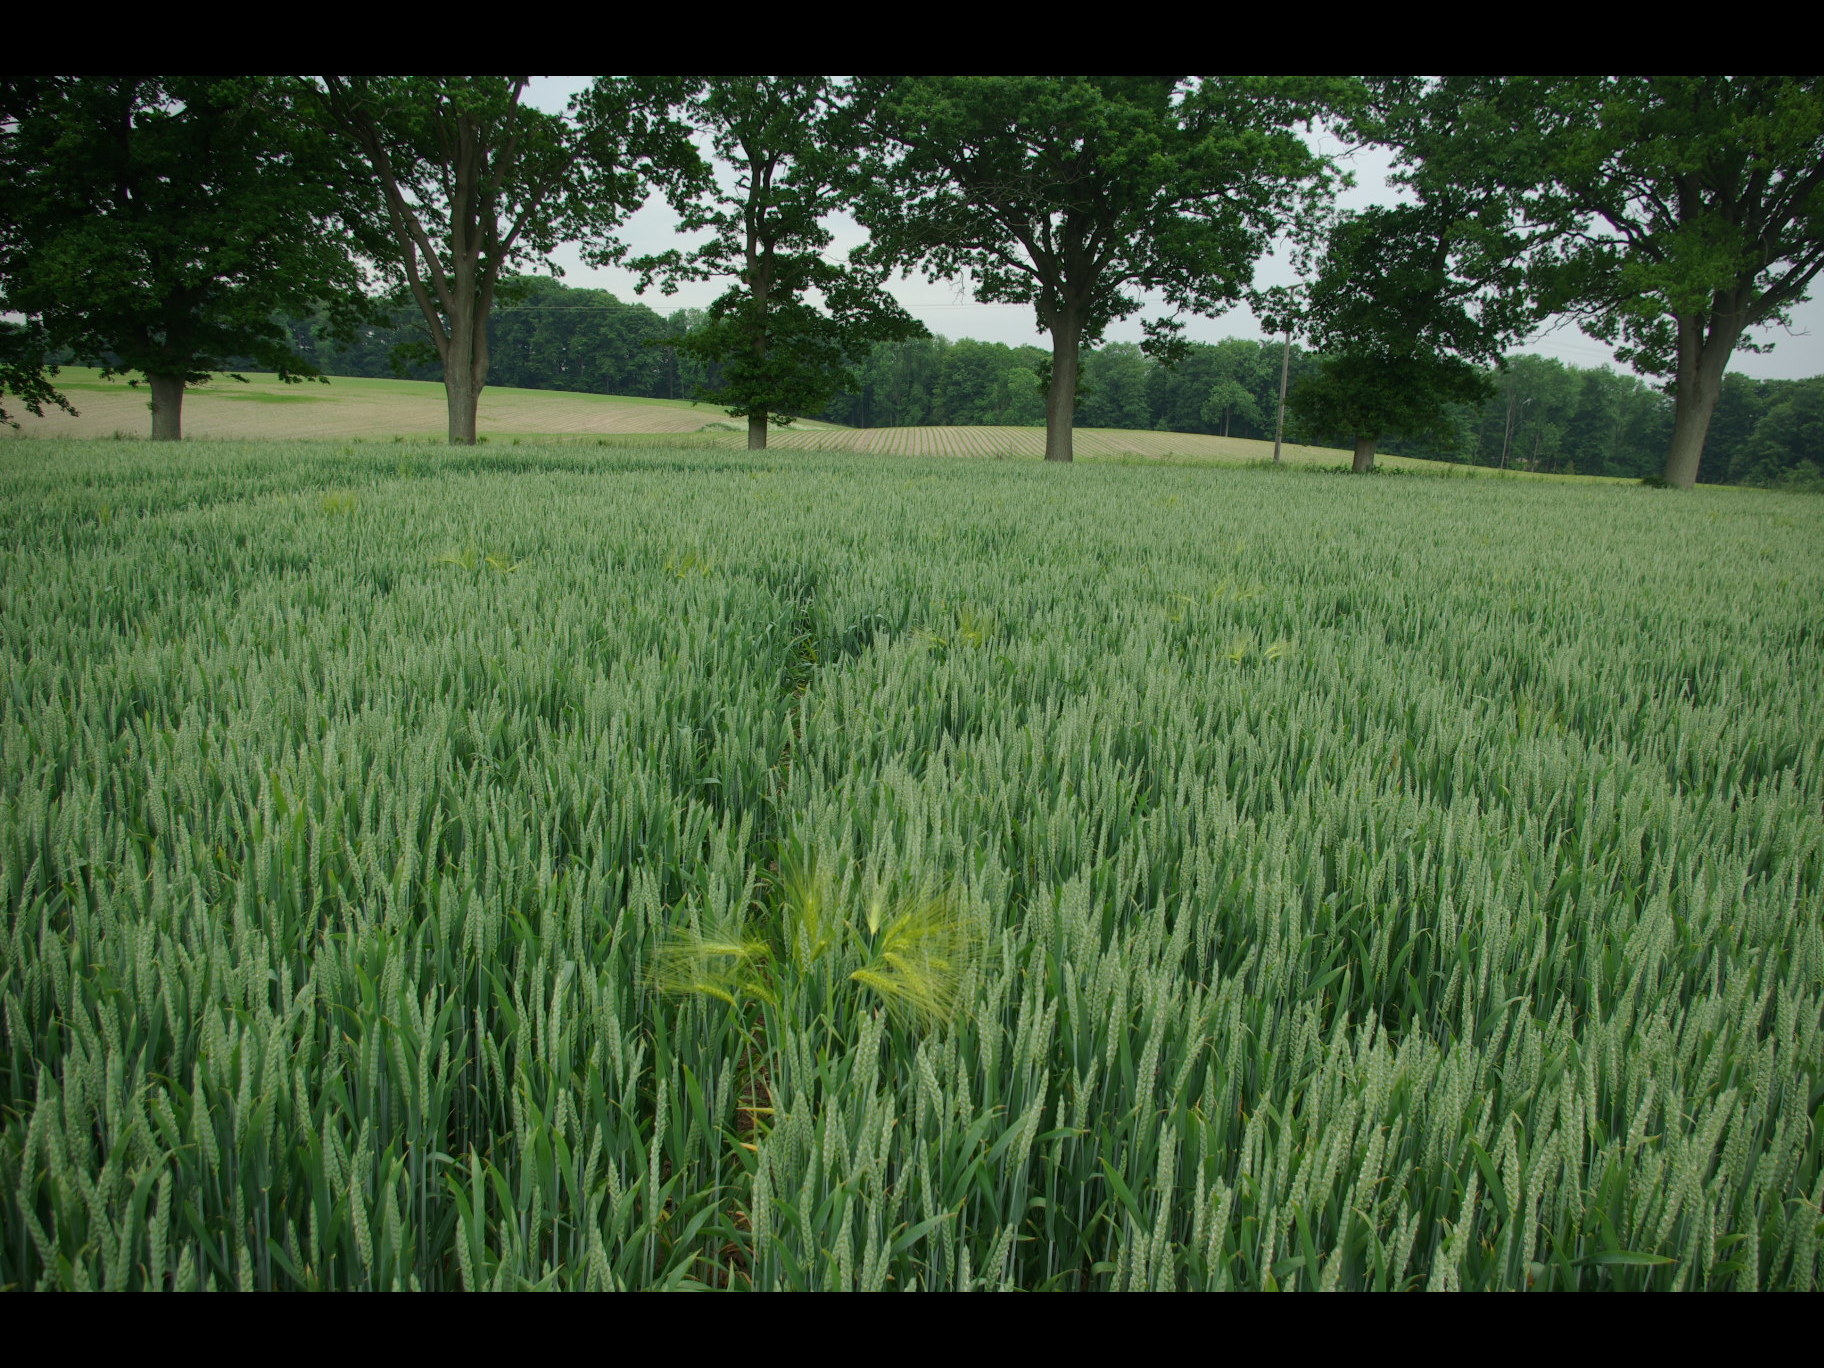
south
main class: Cropland
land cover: Common wheat
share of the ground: > 75 %
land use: Agriculture (excluding fallow land and kitchen gardens)
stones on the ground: 10 - 25 %
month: June
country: DE
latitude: 54.4443
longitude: 9.9538
